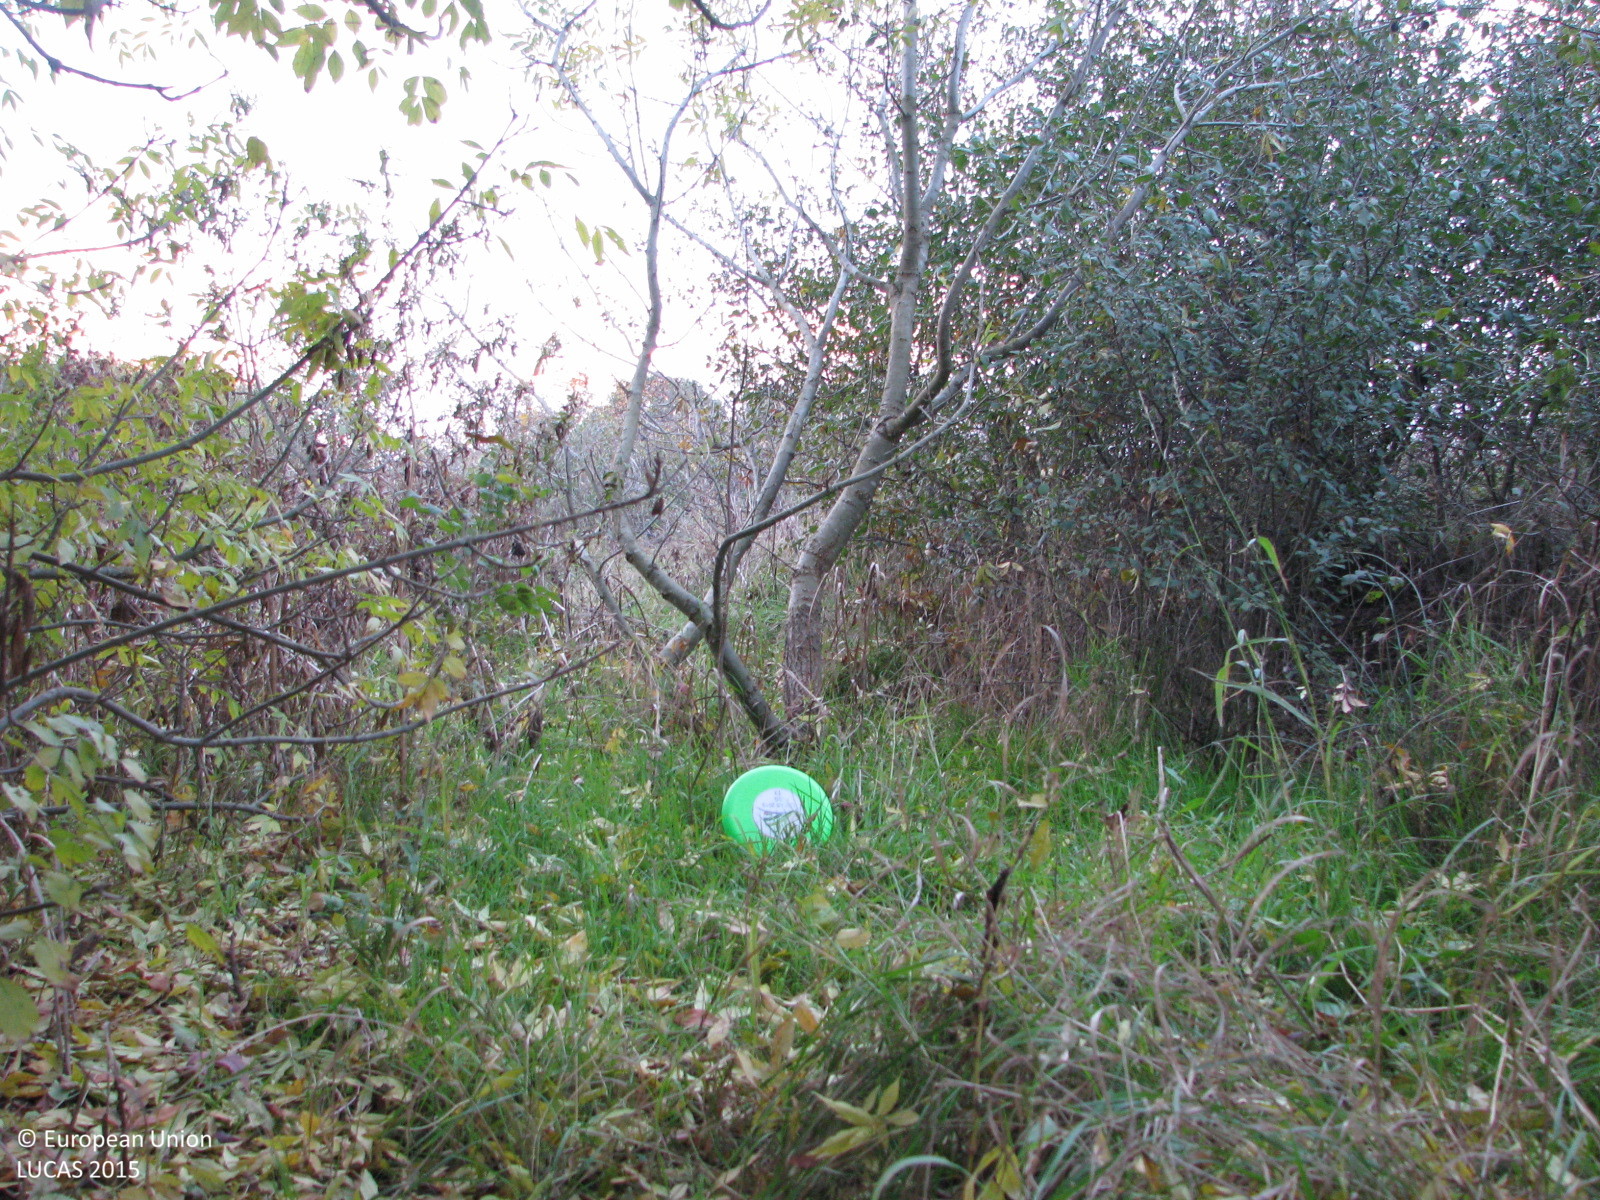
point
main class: Woodland
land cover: Broadleaved woodland
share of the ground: 10 - 25 %
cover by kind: herbaceous plants 65 %, broadleaved forest trees 20 %, shrubs 15 %
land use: Semi-natural and natural areas not in use
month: October
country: BG
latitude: 42.2791
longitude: 26.7442
